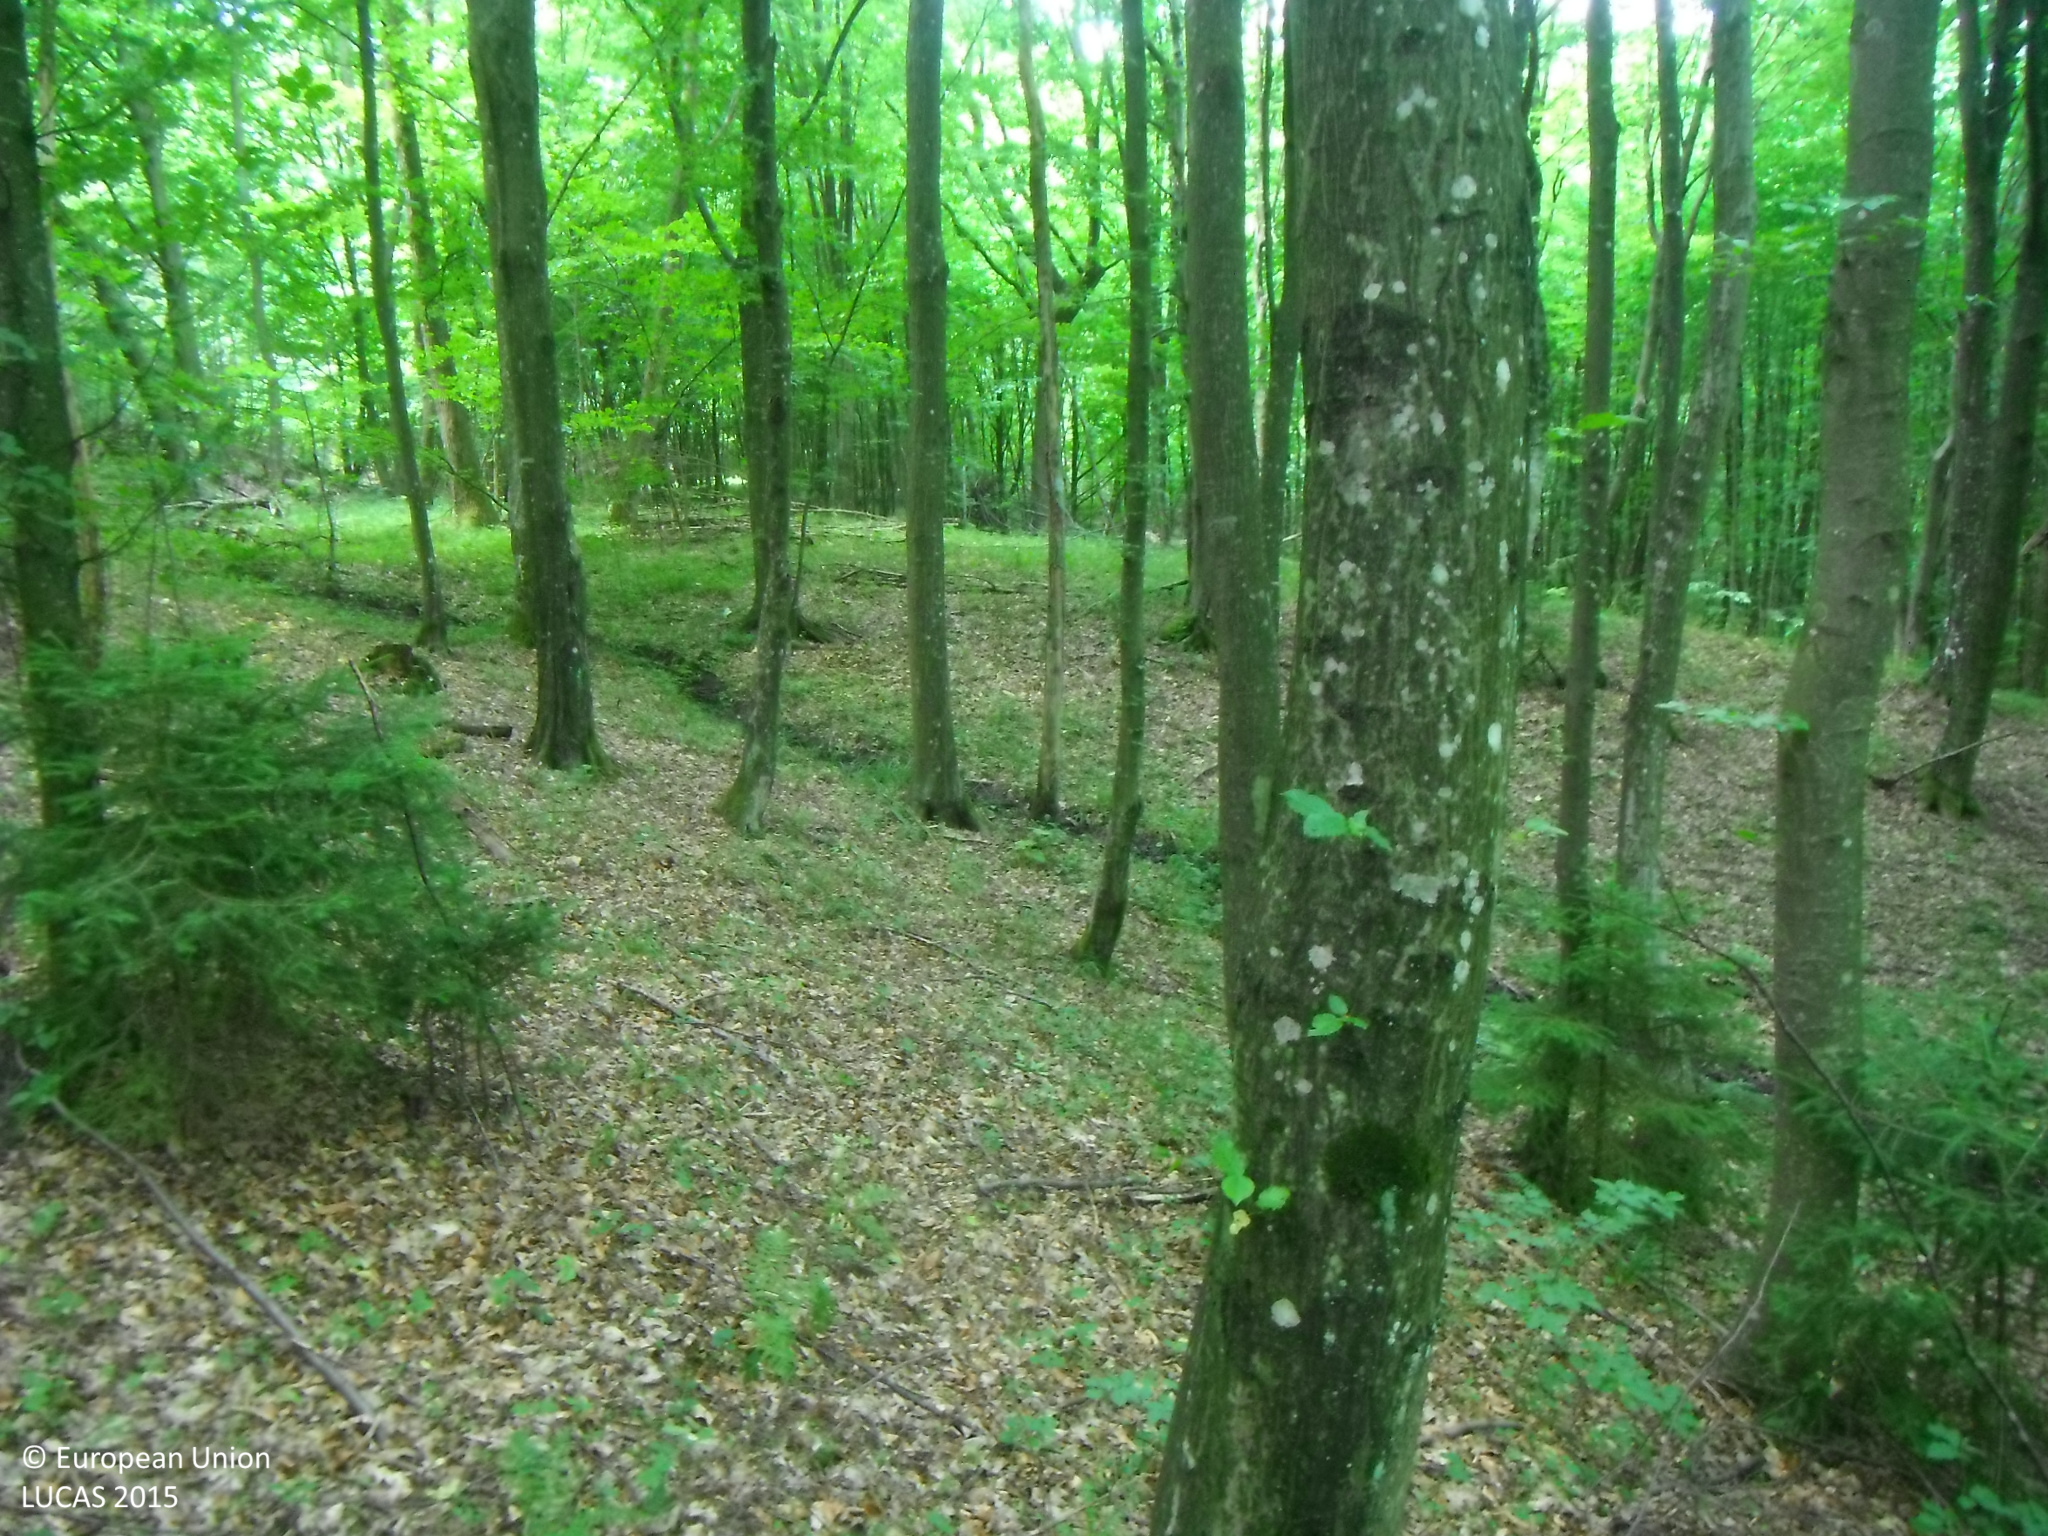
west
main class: Woodland
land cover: Broadleaved woodland
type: beech forest
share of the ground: > 75 %
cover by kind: broadleaved forest trees 100 %
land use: Forestry
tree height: > 5 m
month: June
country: SK
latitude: 48.9087
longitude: 22.3538
